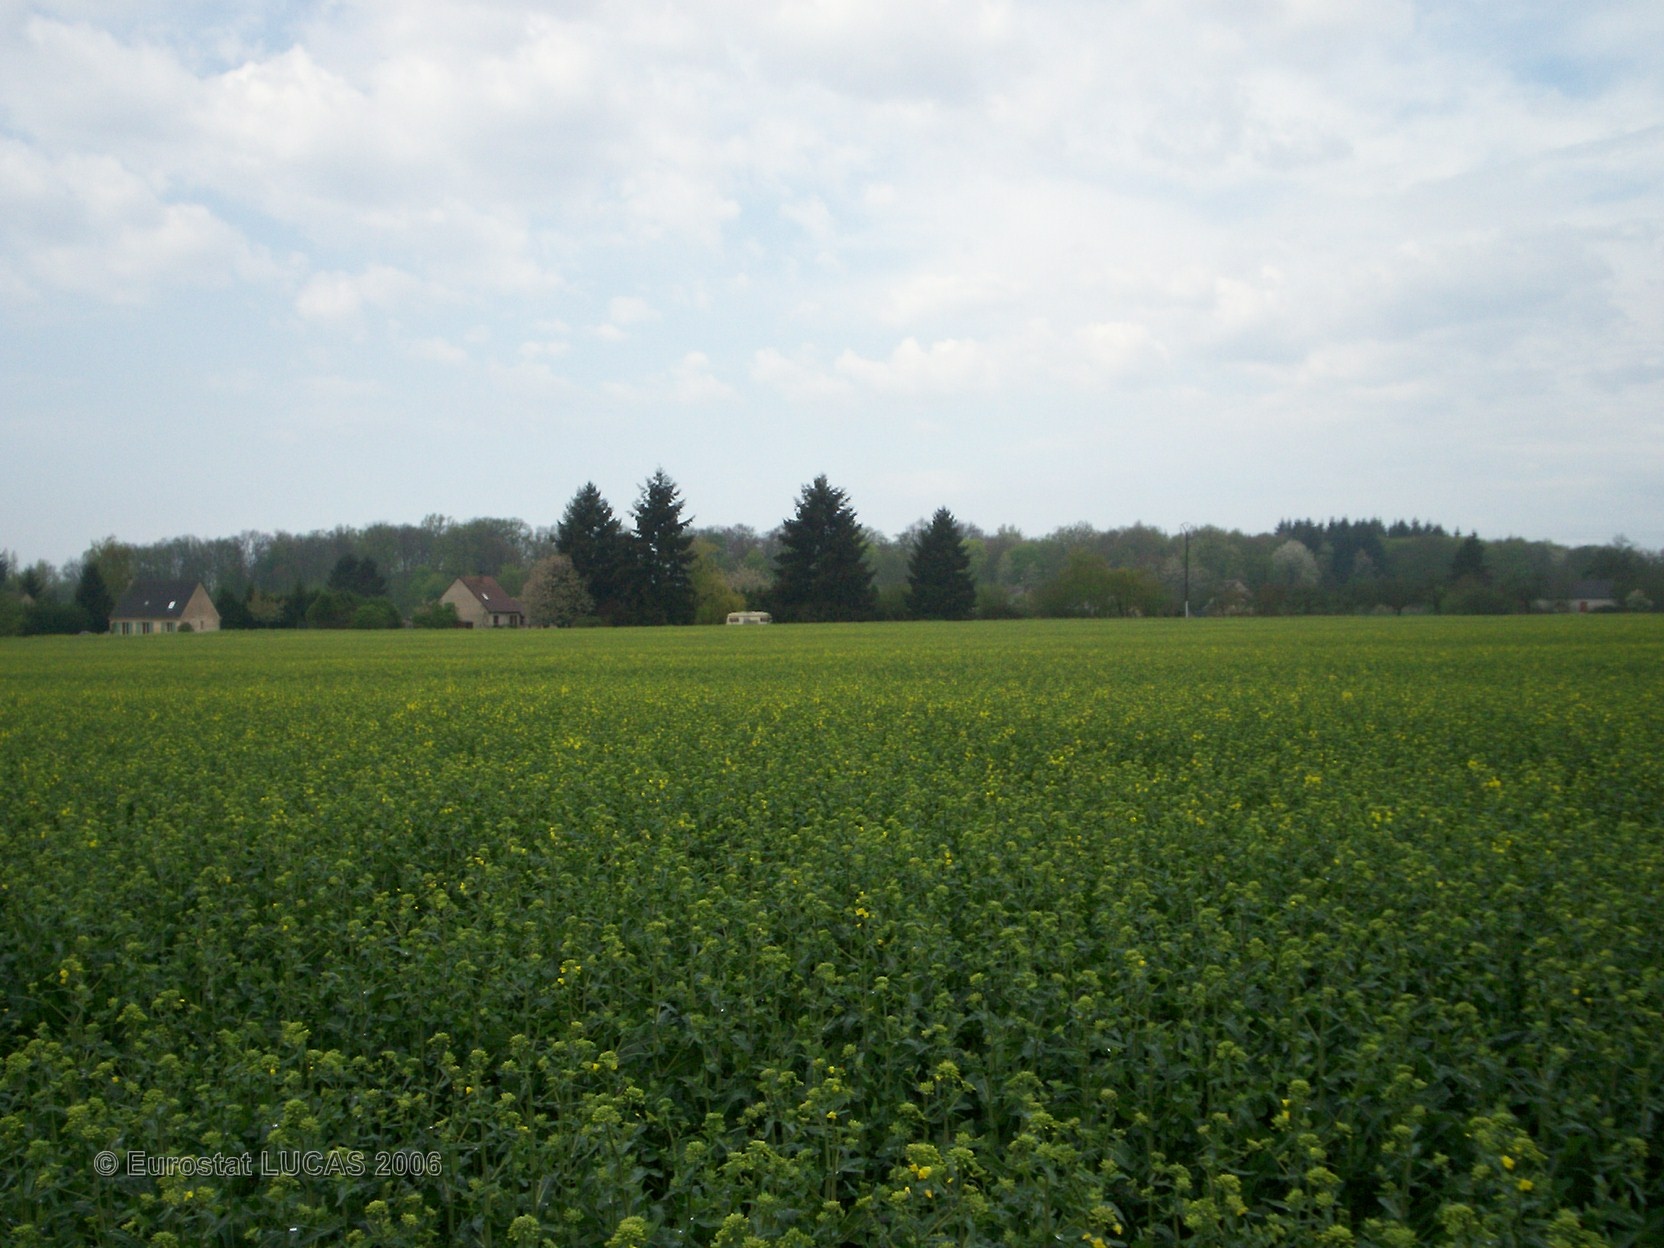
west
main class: Cropland
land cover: Rape and turnip rape
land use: Agriculture (excluding fallow land and kitchen gardens)
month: April
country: FR
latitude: 48.2505
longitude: 2.9485
